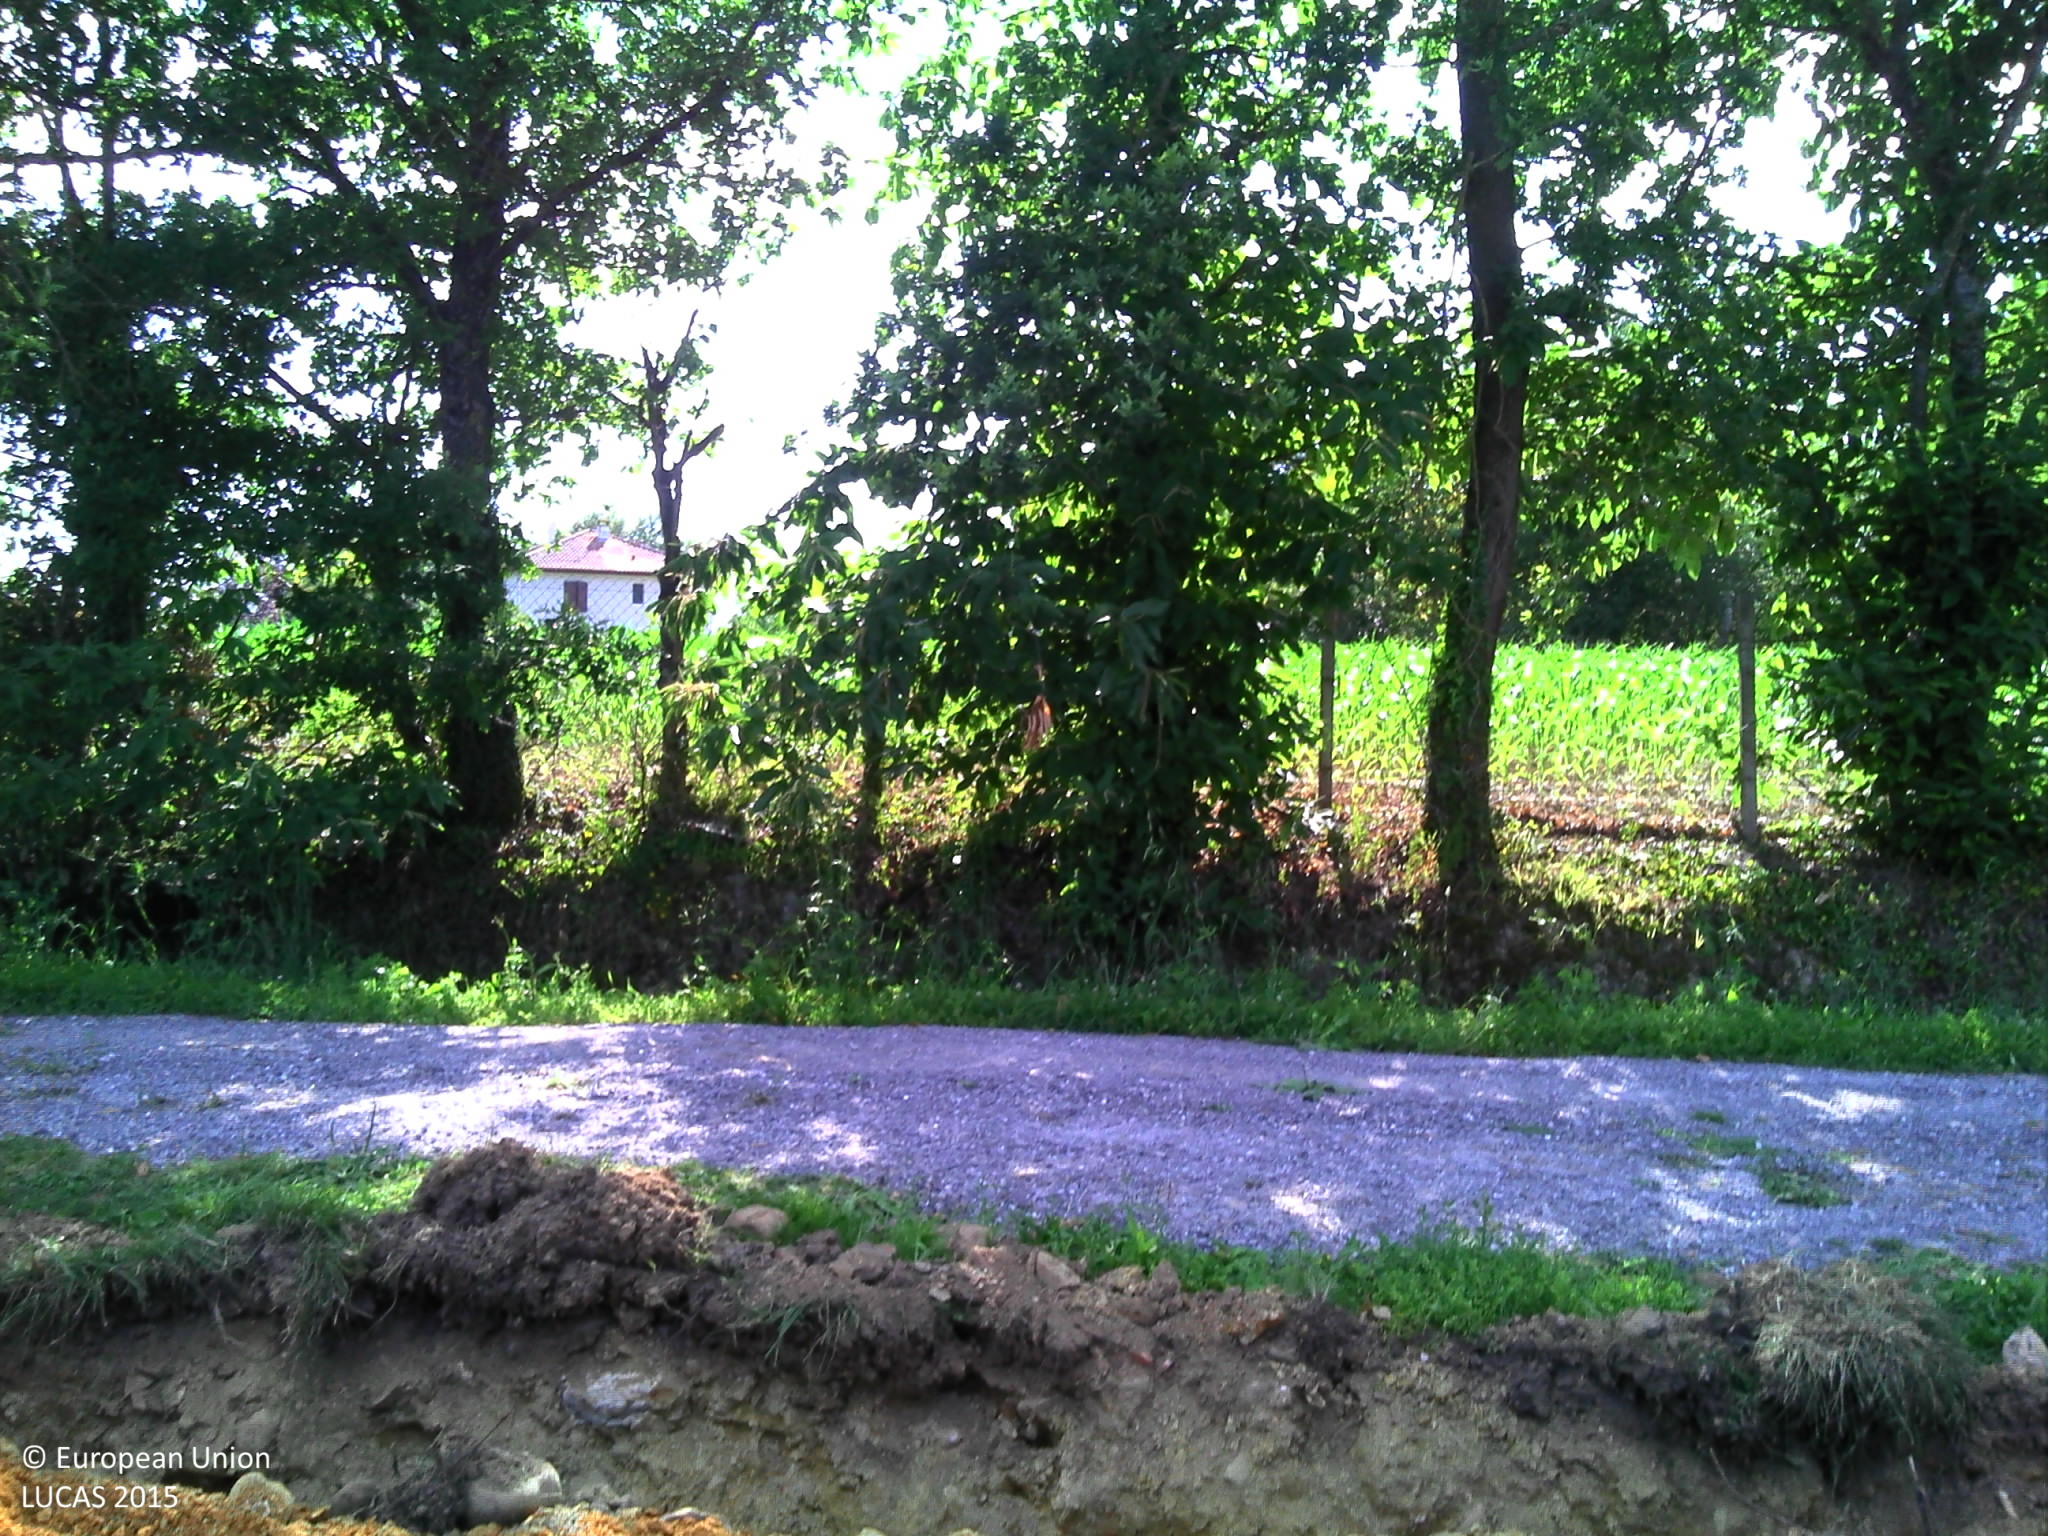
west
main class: Grassland
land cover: Grassland without tree/shrub cover
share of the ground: > 75 %
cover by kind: herbaceous plants 100 %
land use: Agriculture (excluding fallow land and kitchen gardens)
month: June
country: FR
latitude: 43.6362
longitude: -0.4841
